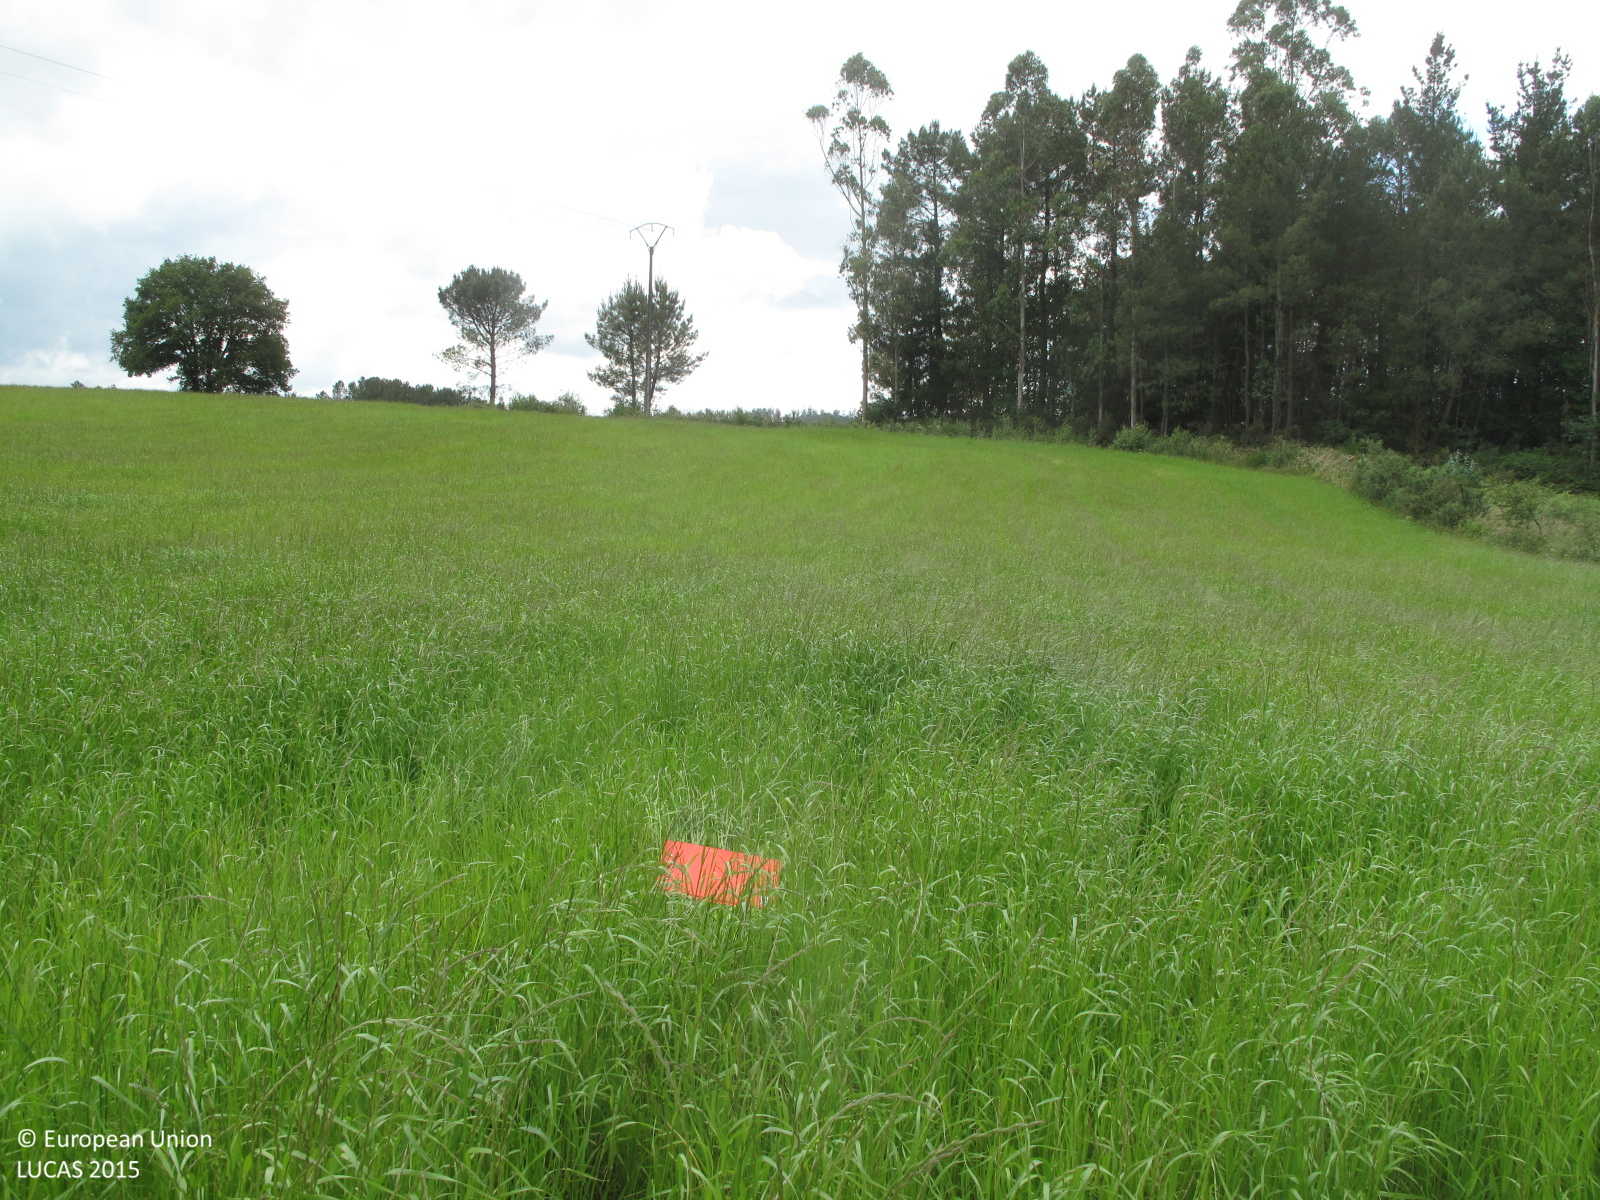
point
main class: Grassland
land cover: Grassland without tree/shrub cover
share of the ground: > 75 %
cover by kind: herbaceous plants 100 %
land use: Agriculture (excluding fallow land and kitchen gardens)
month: June
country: ES
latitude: 43.0202
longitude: -8.4991
